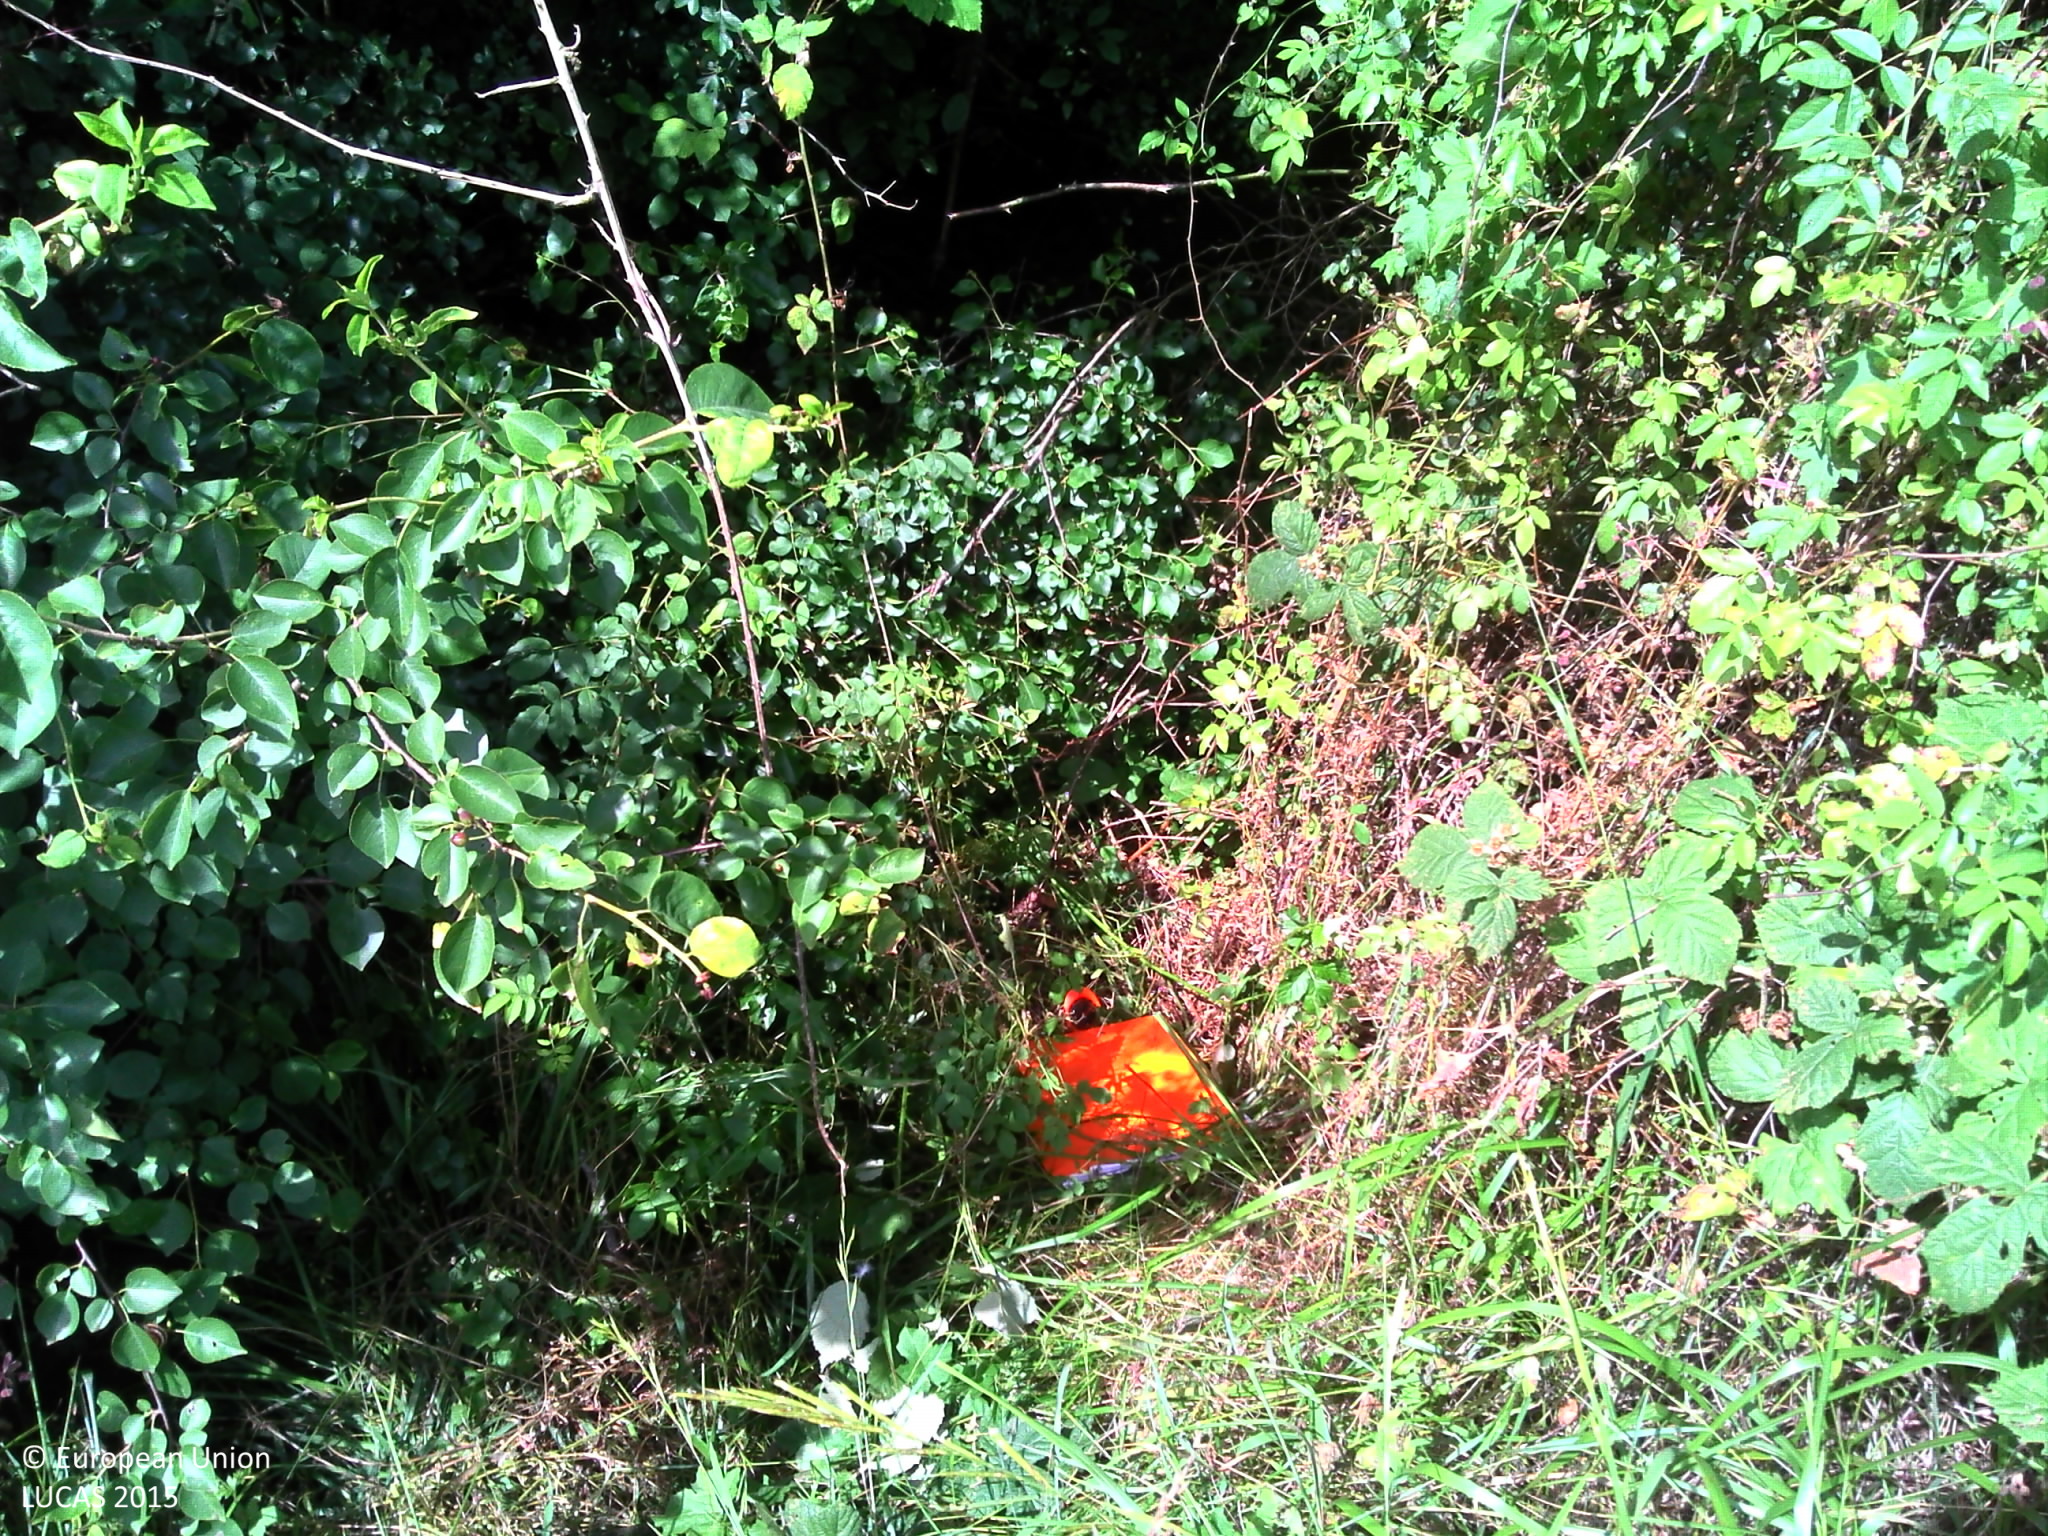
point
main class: Woodland
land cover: Pine dominated mixed woodland
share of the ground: 25 - 50 %
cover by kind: coniferous forest trees 50 %, broadleaved forest trees 30 %, shrubs 10 %, herbaceous plants 10 %
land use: Semi-natural and natural areas not in use
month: June
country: FR
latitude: 47.4350
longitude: 3.4862
